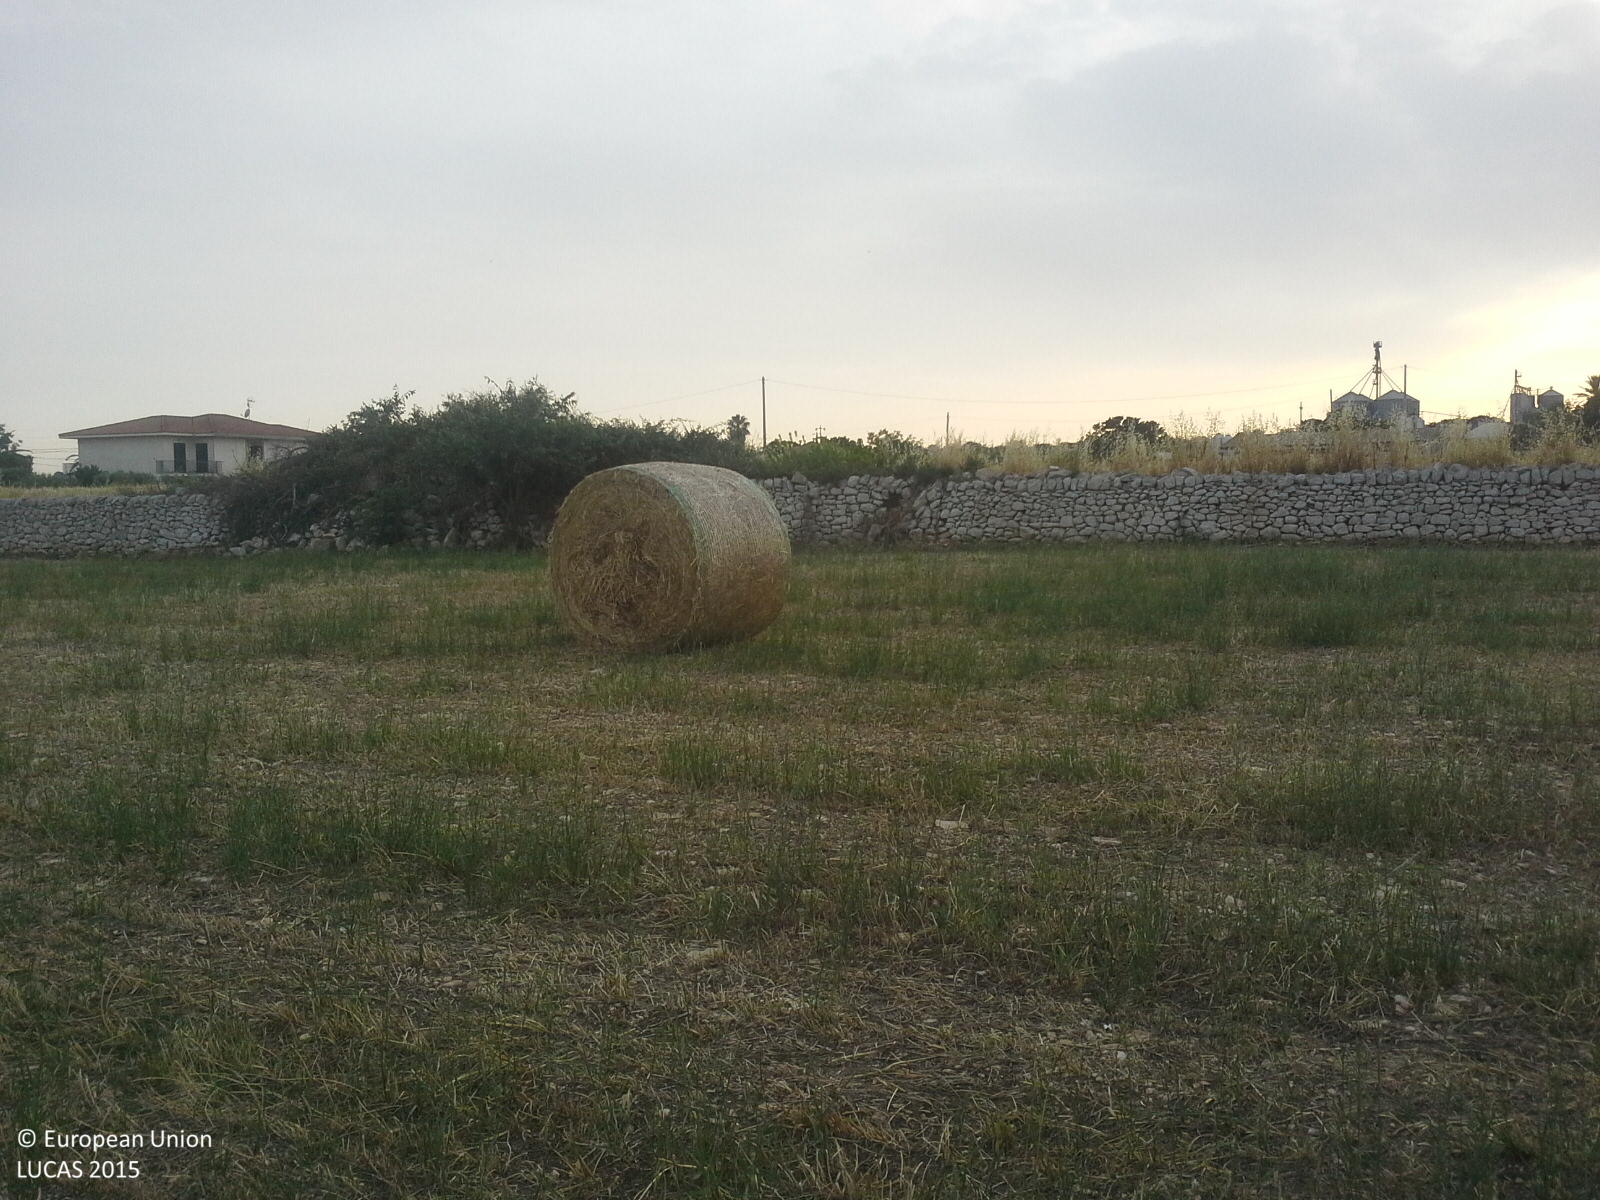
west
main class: Cropland
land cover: Mixed cereals for fodder
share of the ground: > 75 %
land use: Agriculture (excluding fallow land and kitchen gardens)
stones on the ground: < 10 %
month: May
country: IT
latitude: 36.8795
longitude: 14.8196
